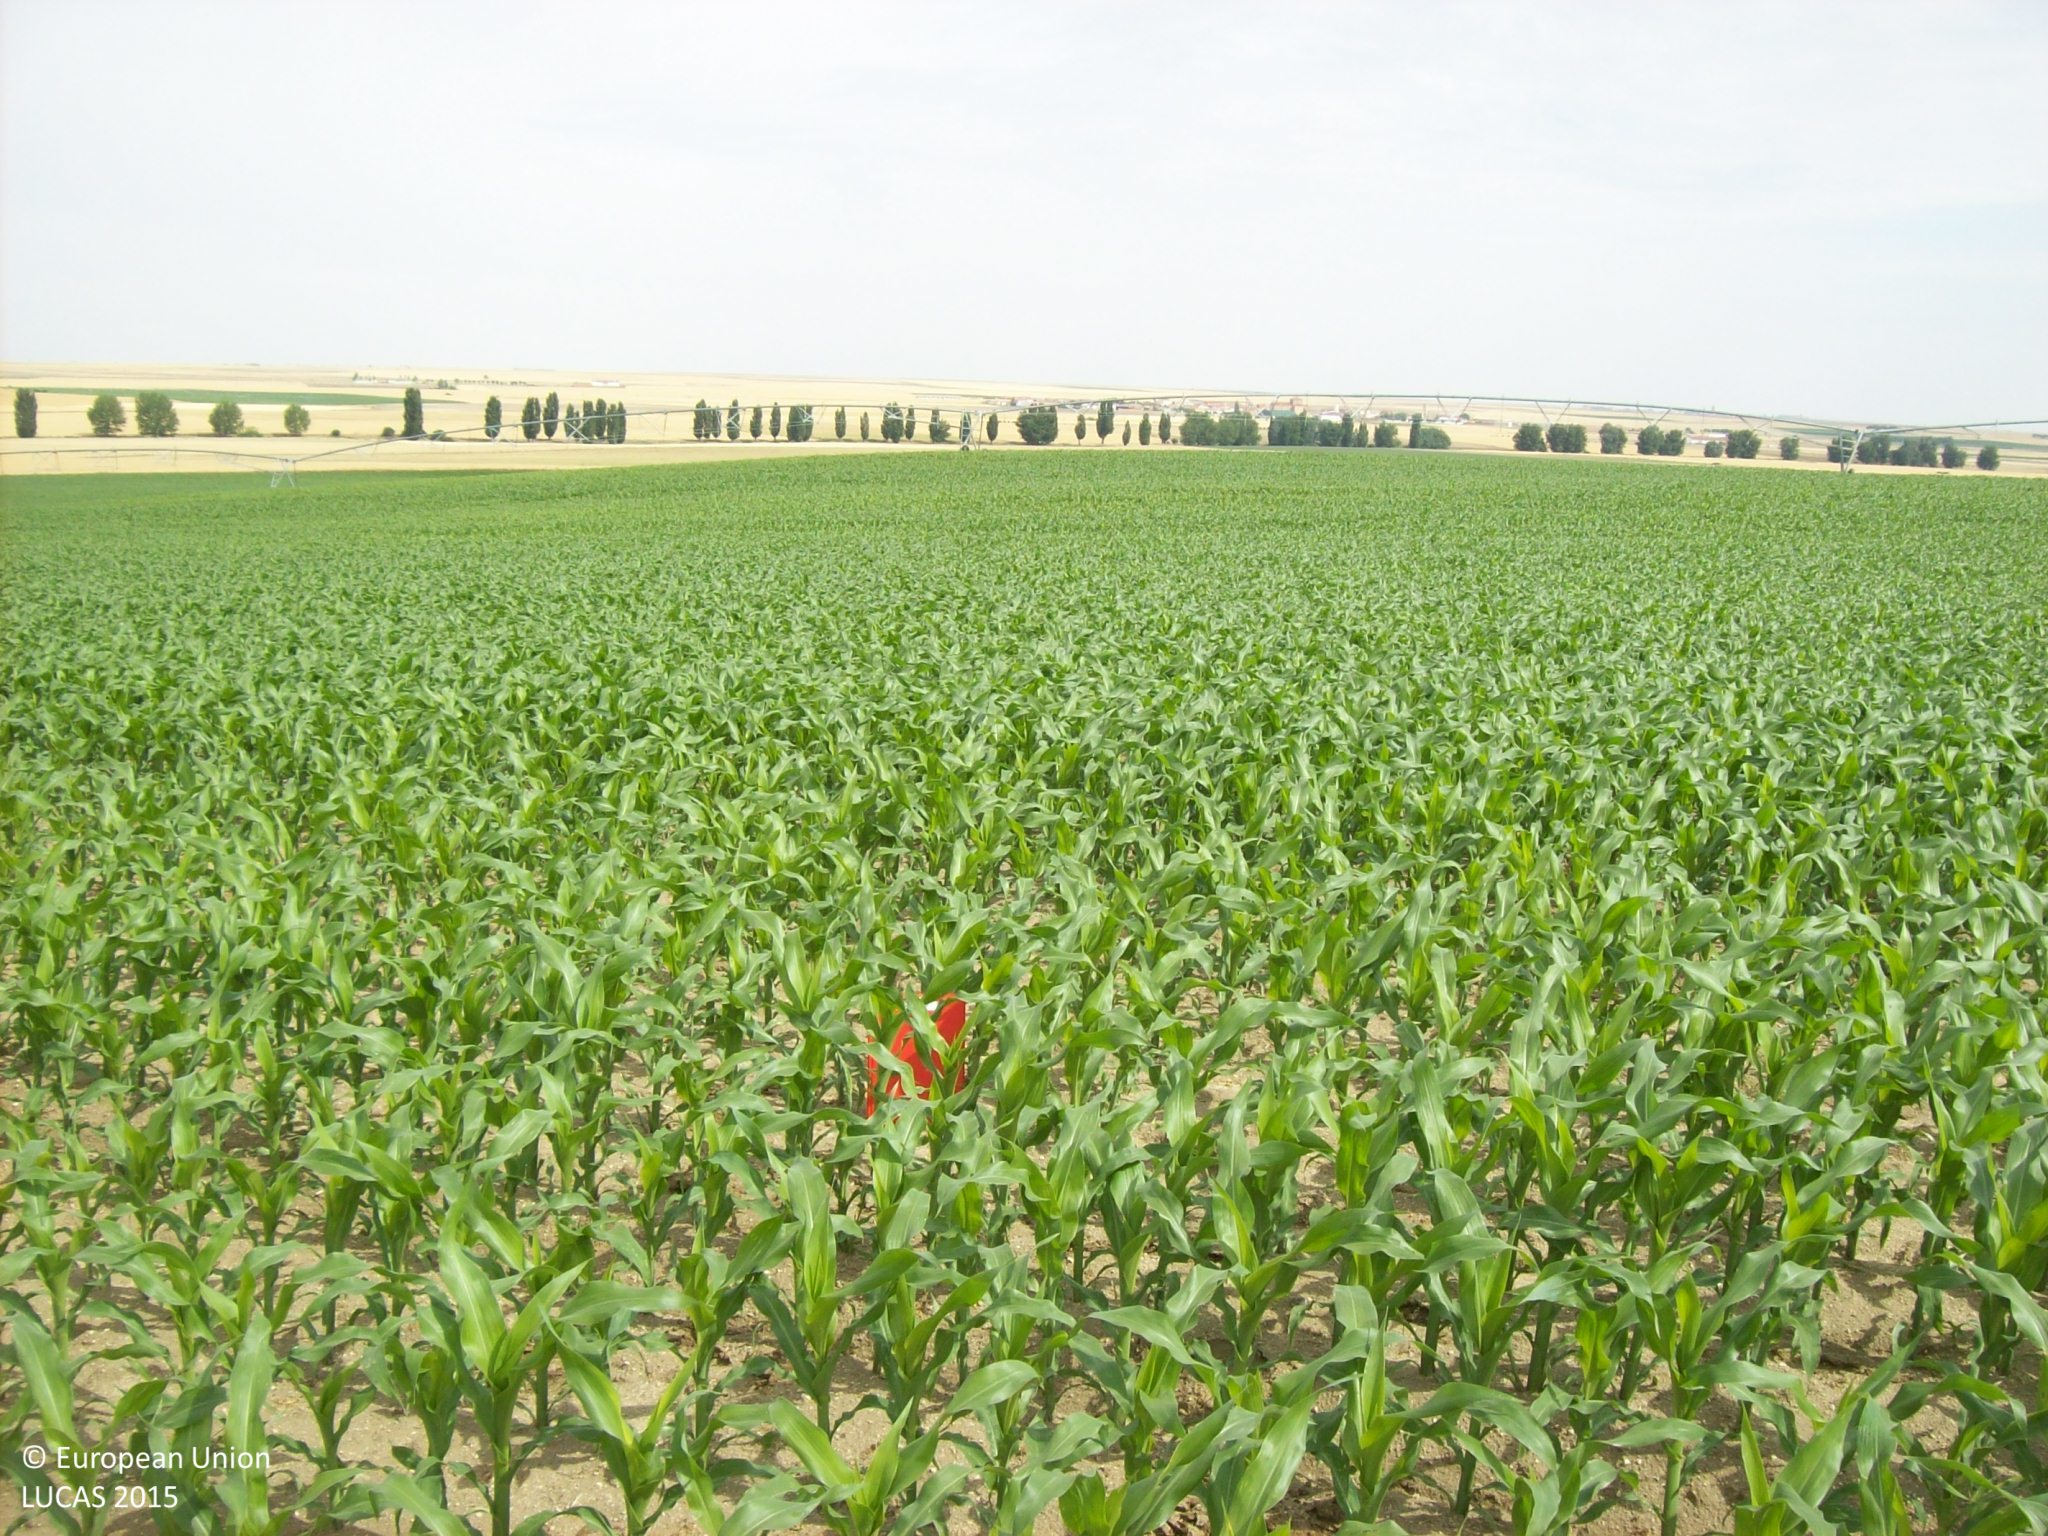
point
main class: Cropland
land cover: Maize
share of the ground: > 75 %
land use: Agriculture (excluding fallow land and kitchen gardens)
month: June
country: ES
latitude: 40.9964
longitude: -5.0085
